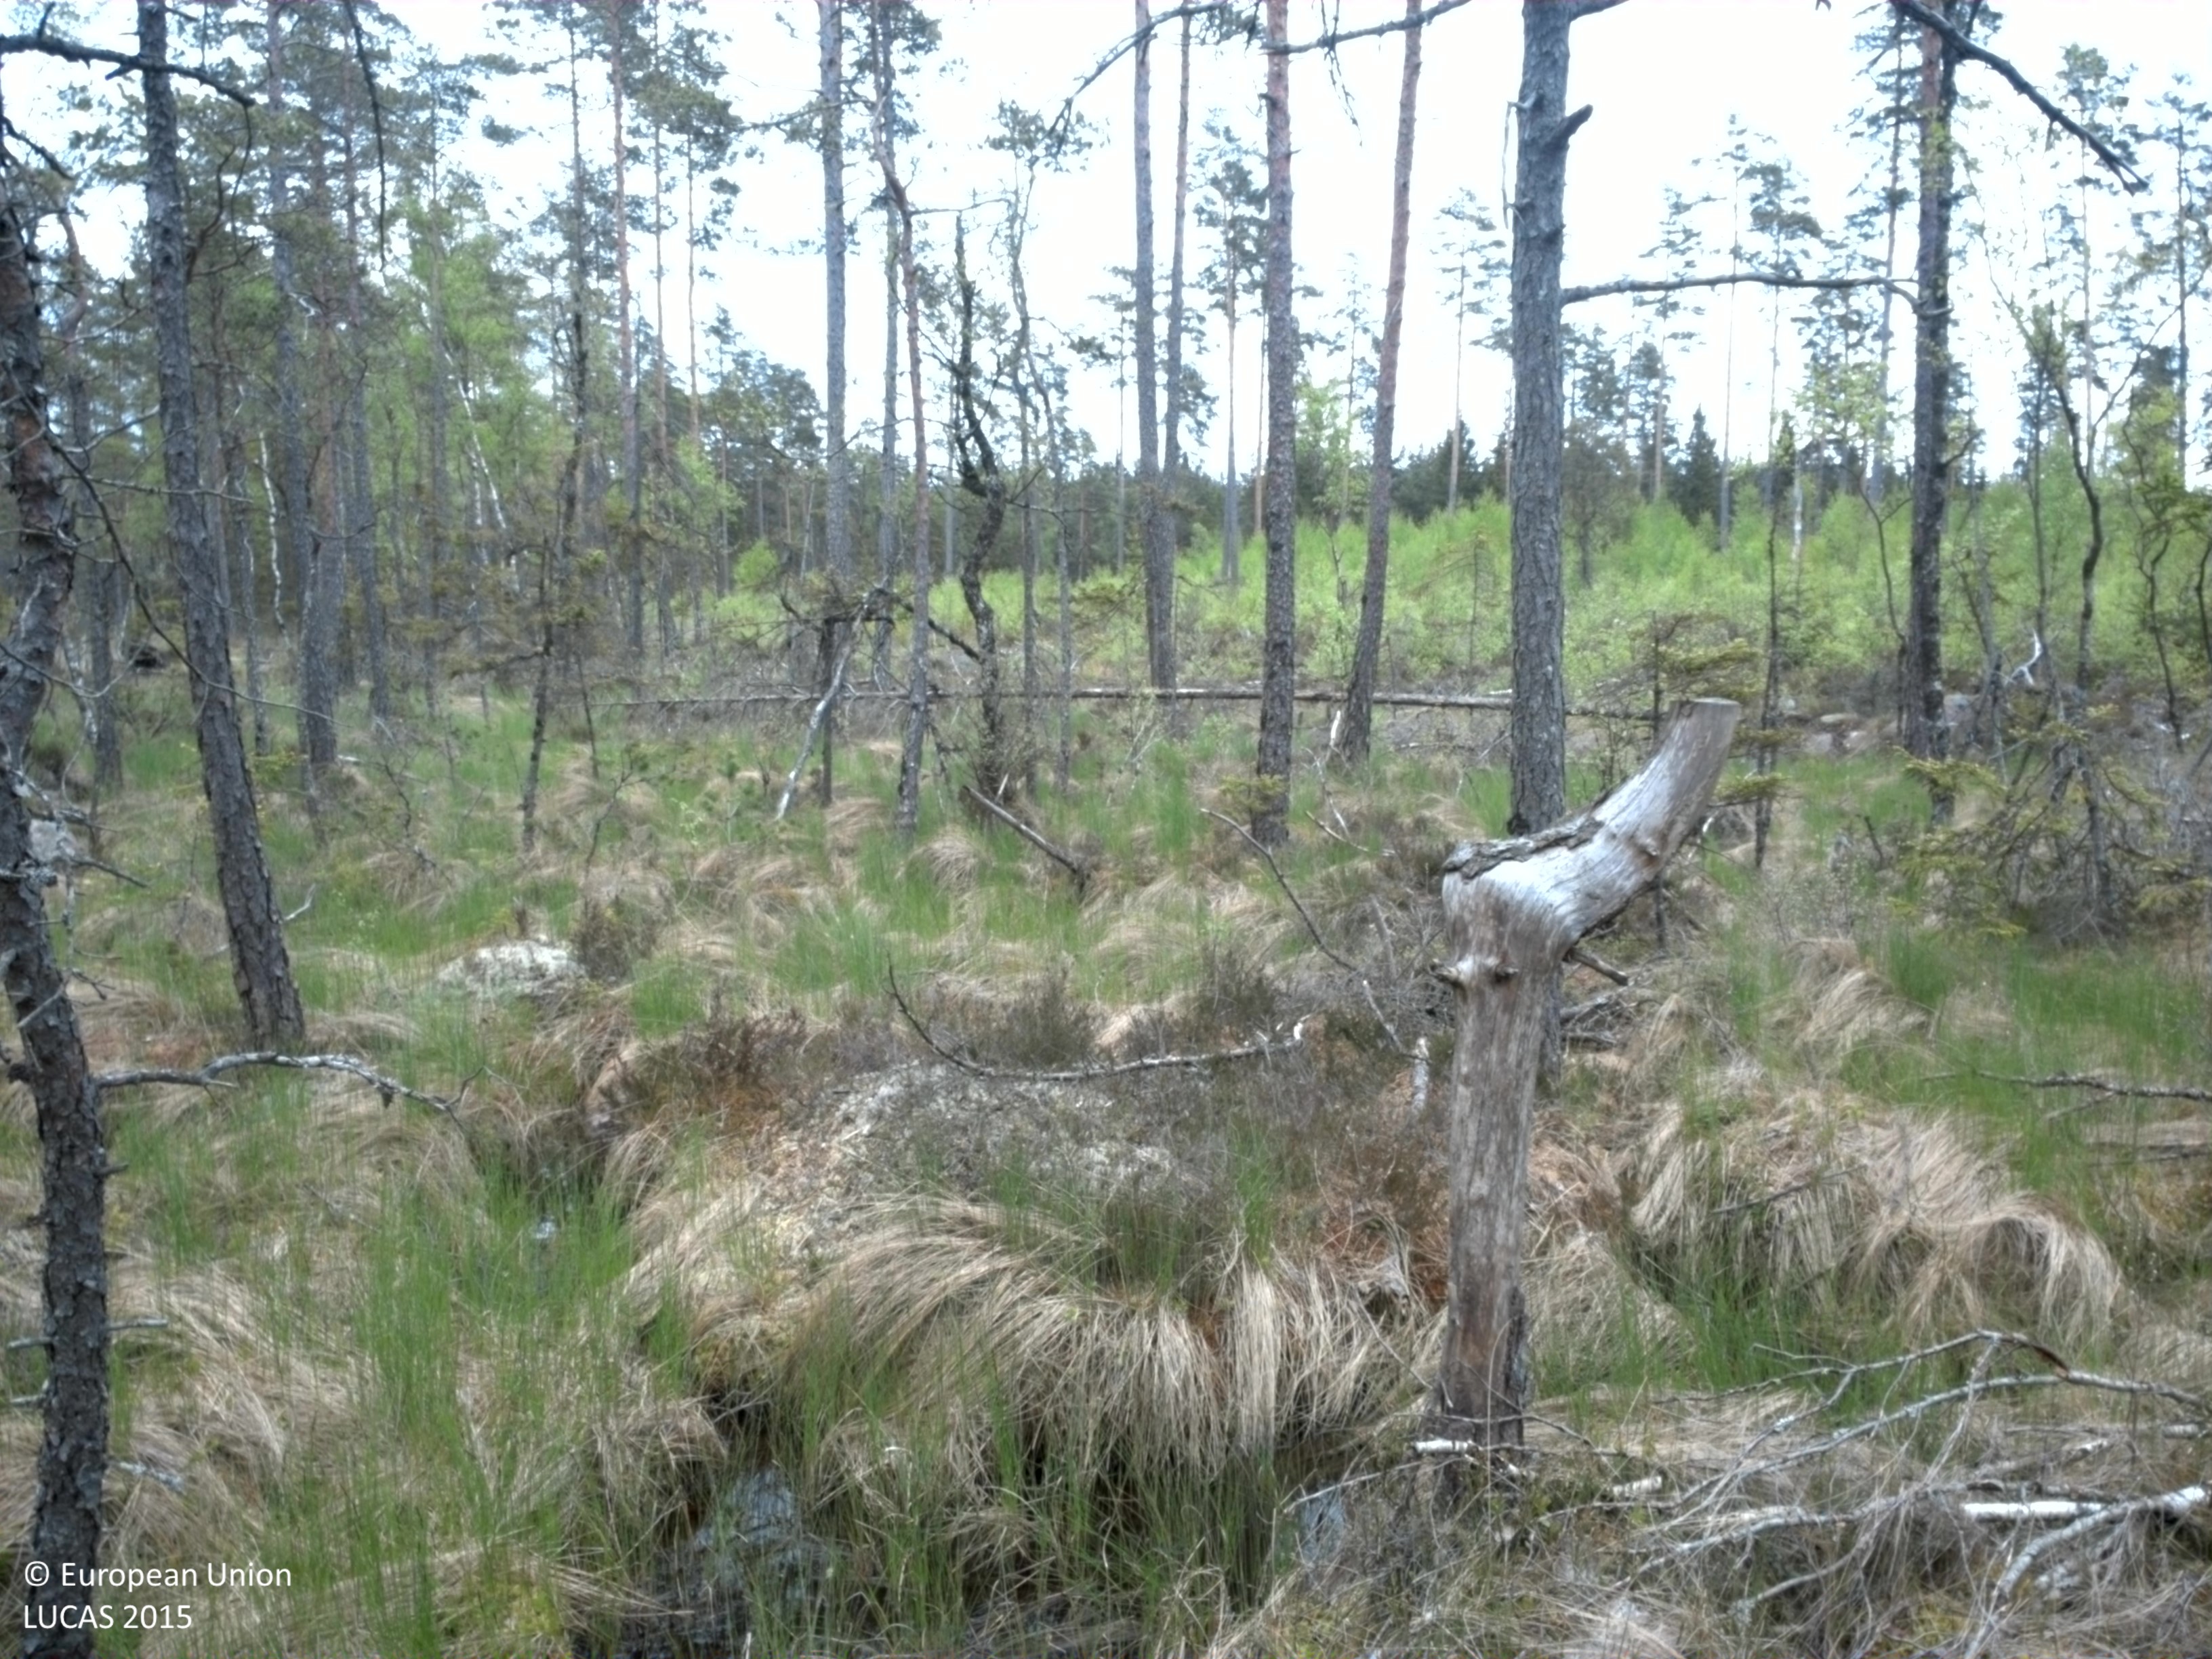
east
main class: Woodland
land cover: Pine dominated coniferous woodland
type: boreal forest
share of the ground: 50 - 75 %
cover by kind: coniferous forest trees 55 %, lichens and mosses 30 %, broadleaved forest trees 15 %
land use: Forestry
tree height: > 5 m
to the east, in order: Pine dominated coniferous woodland; Rivers and streams; Pine dominated coniferous woodland; Shrubland with sparse tree cover; Spruce dominated mixed woodland; Pine dominated mixed woodland; Pine dominated coniferous woodland; Inland marshes; Pine dominated coniferous woodland
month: May
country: SE
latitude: 56.9330
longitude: 15.1081
